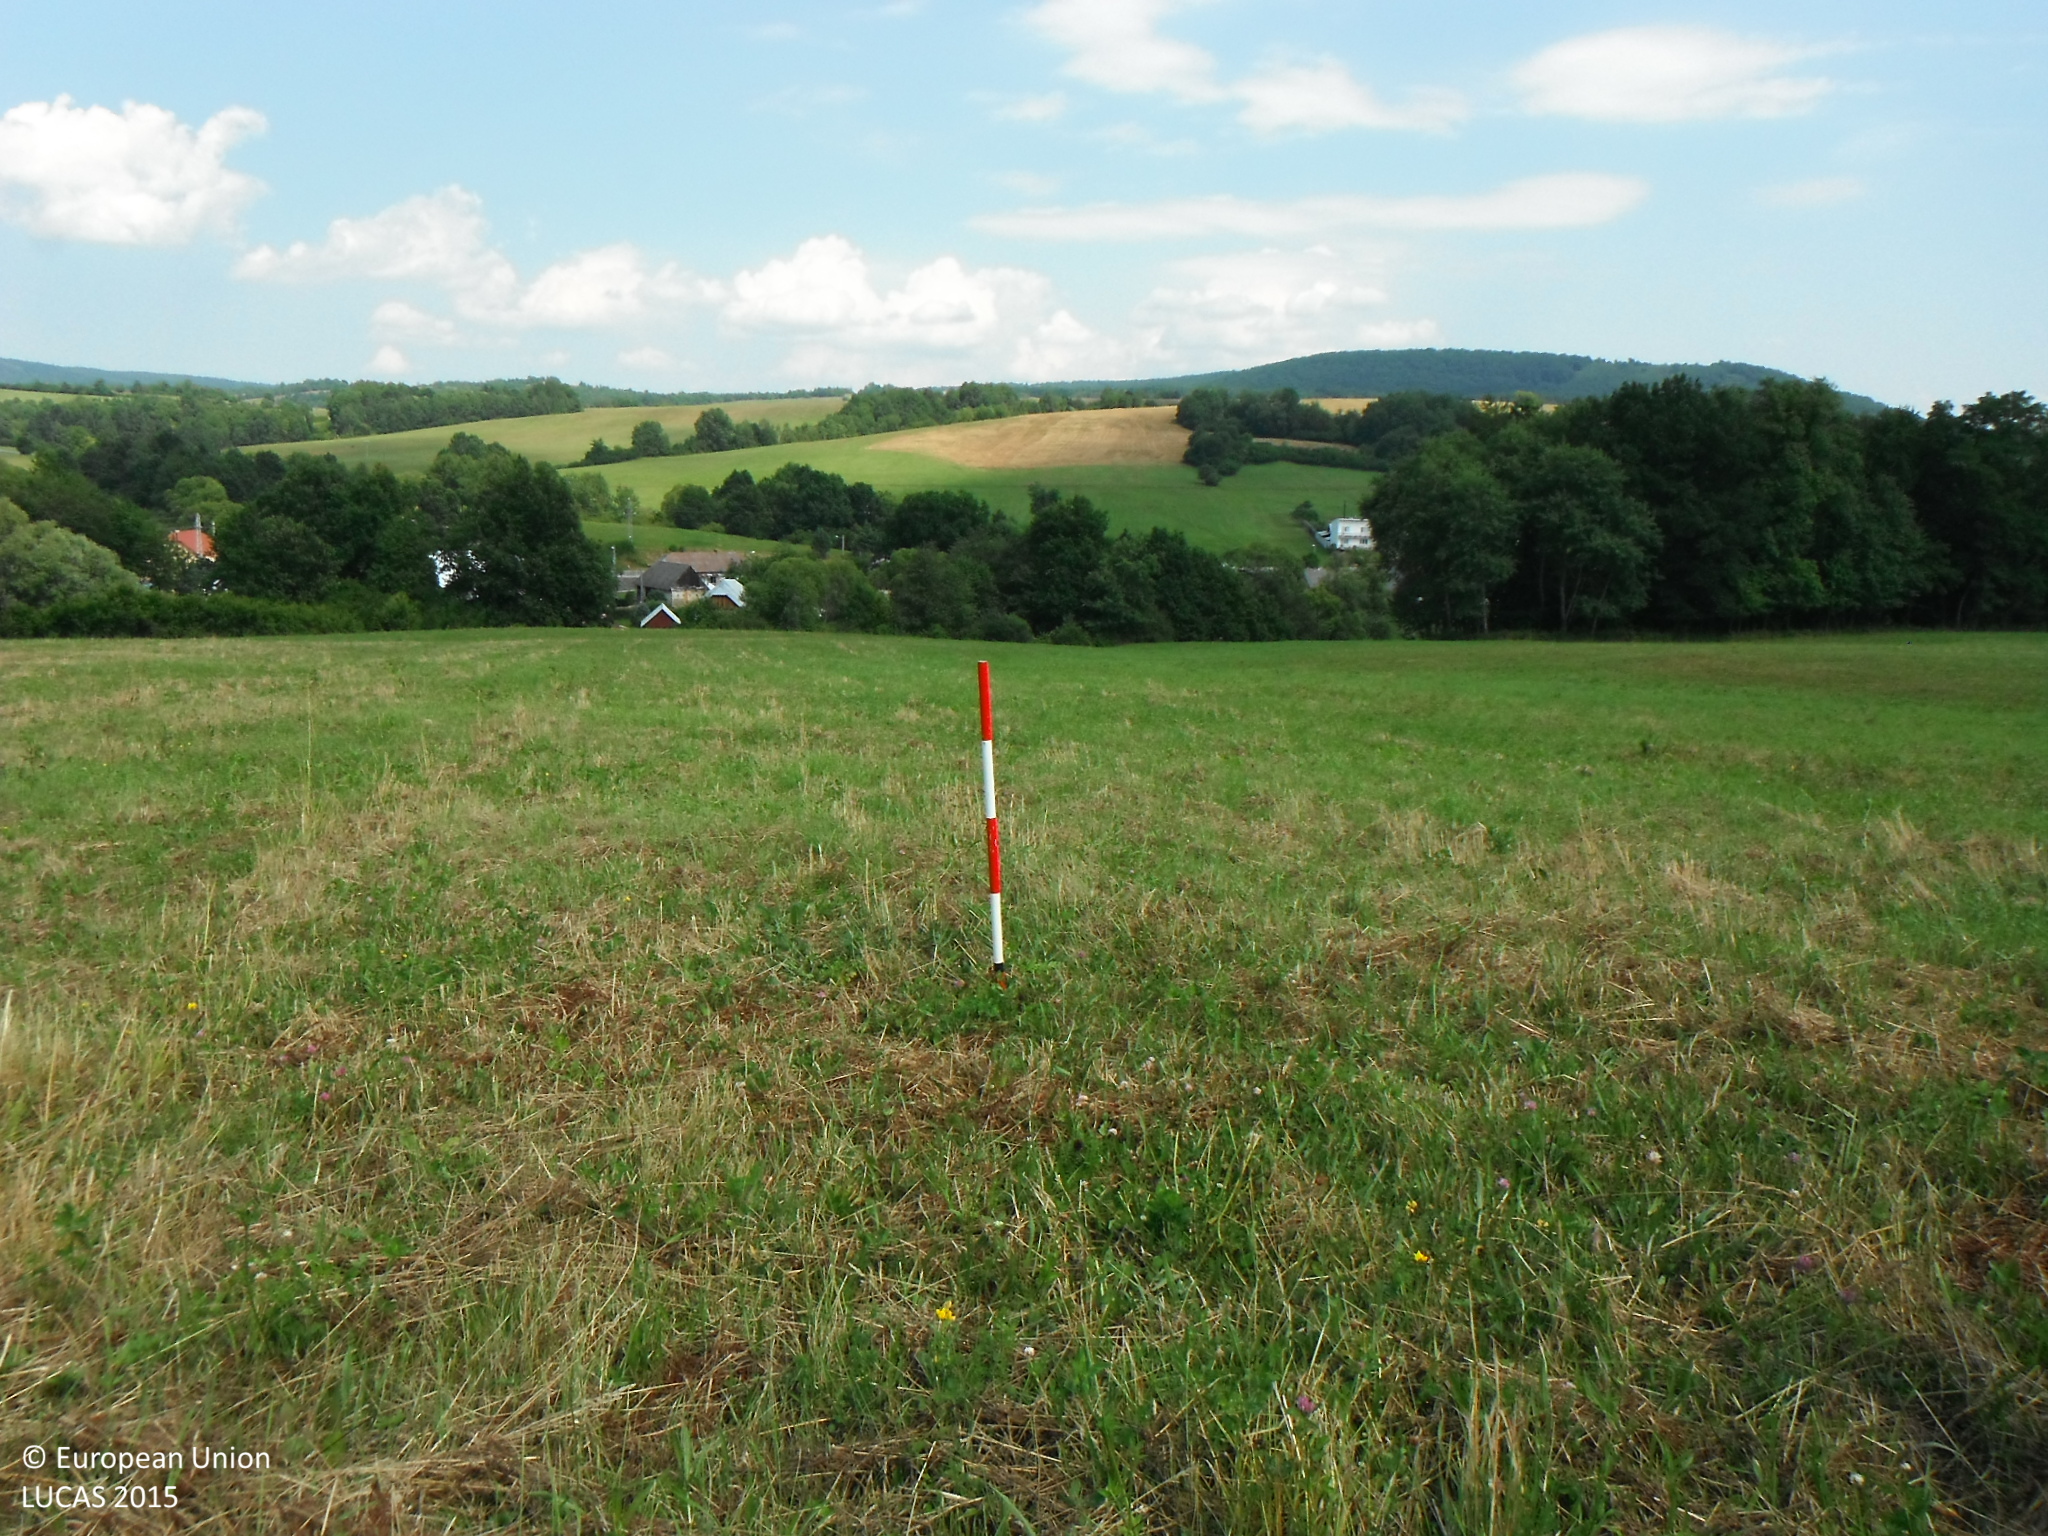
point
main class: Grassland
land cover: Grassland without tree/shrub cover
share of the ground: > 75 %
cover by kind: herbaceous plants 100 %
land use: Agriculture (excluding fallow land and kitchen gardens)
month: July
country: SK
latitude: 49.3676
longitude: 21.4647
